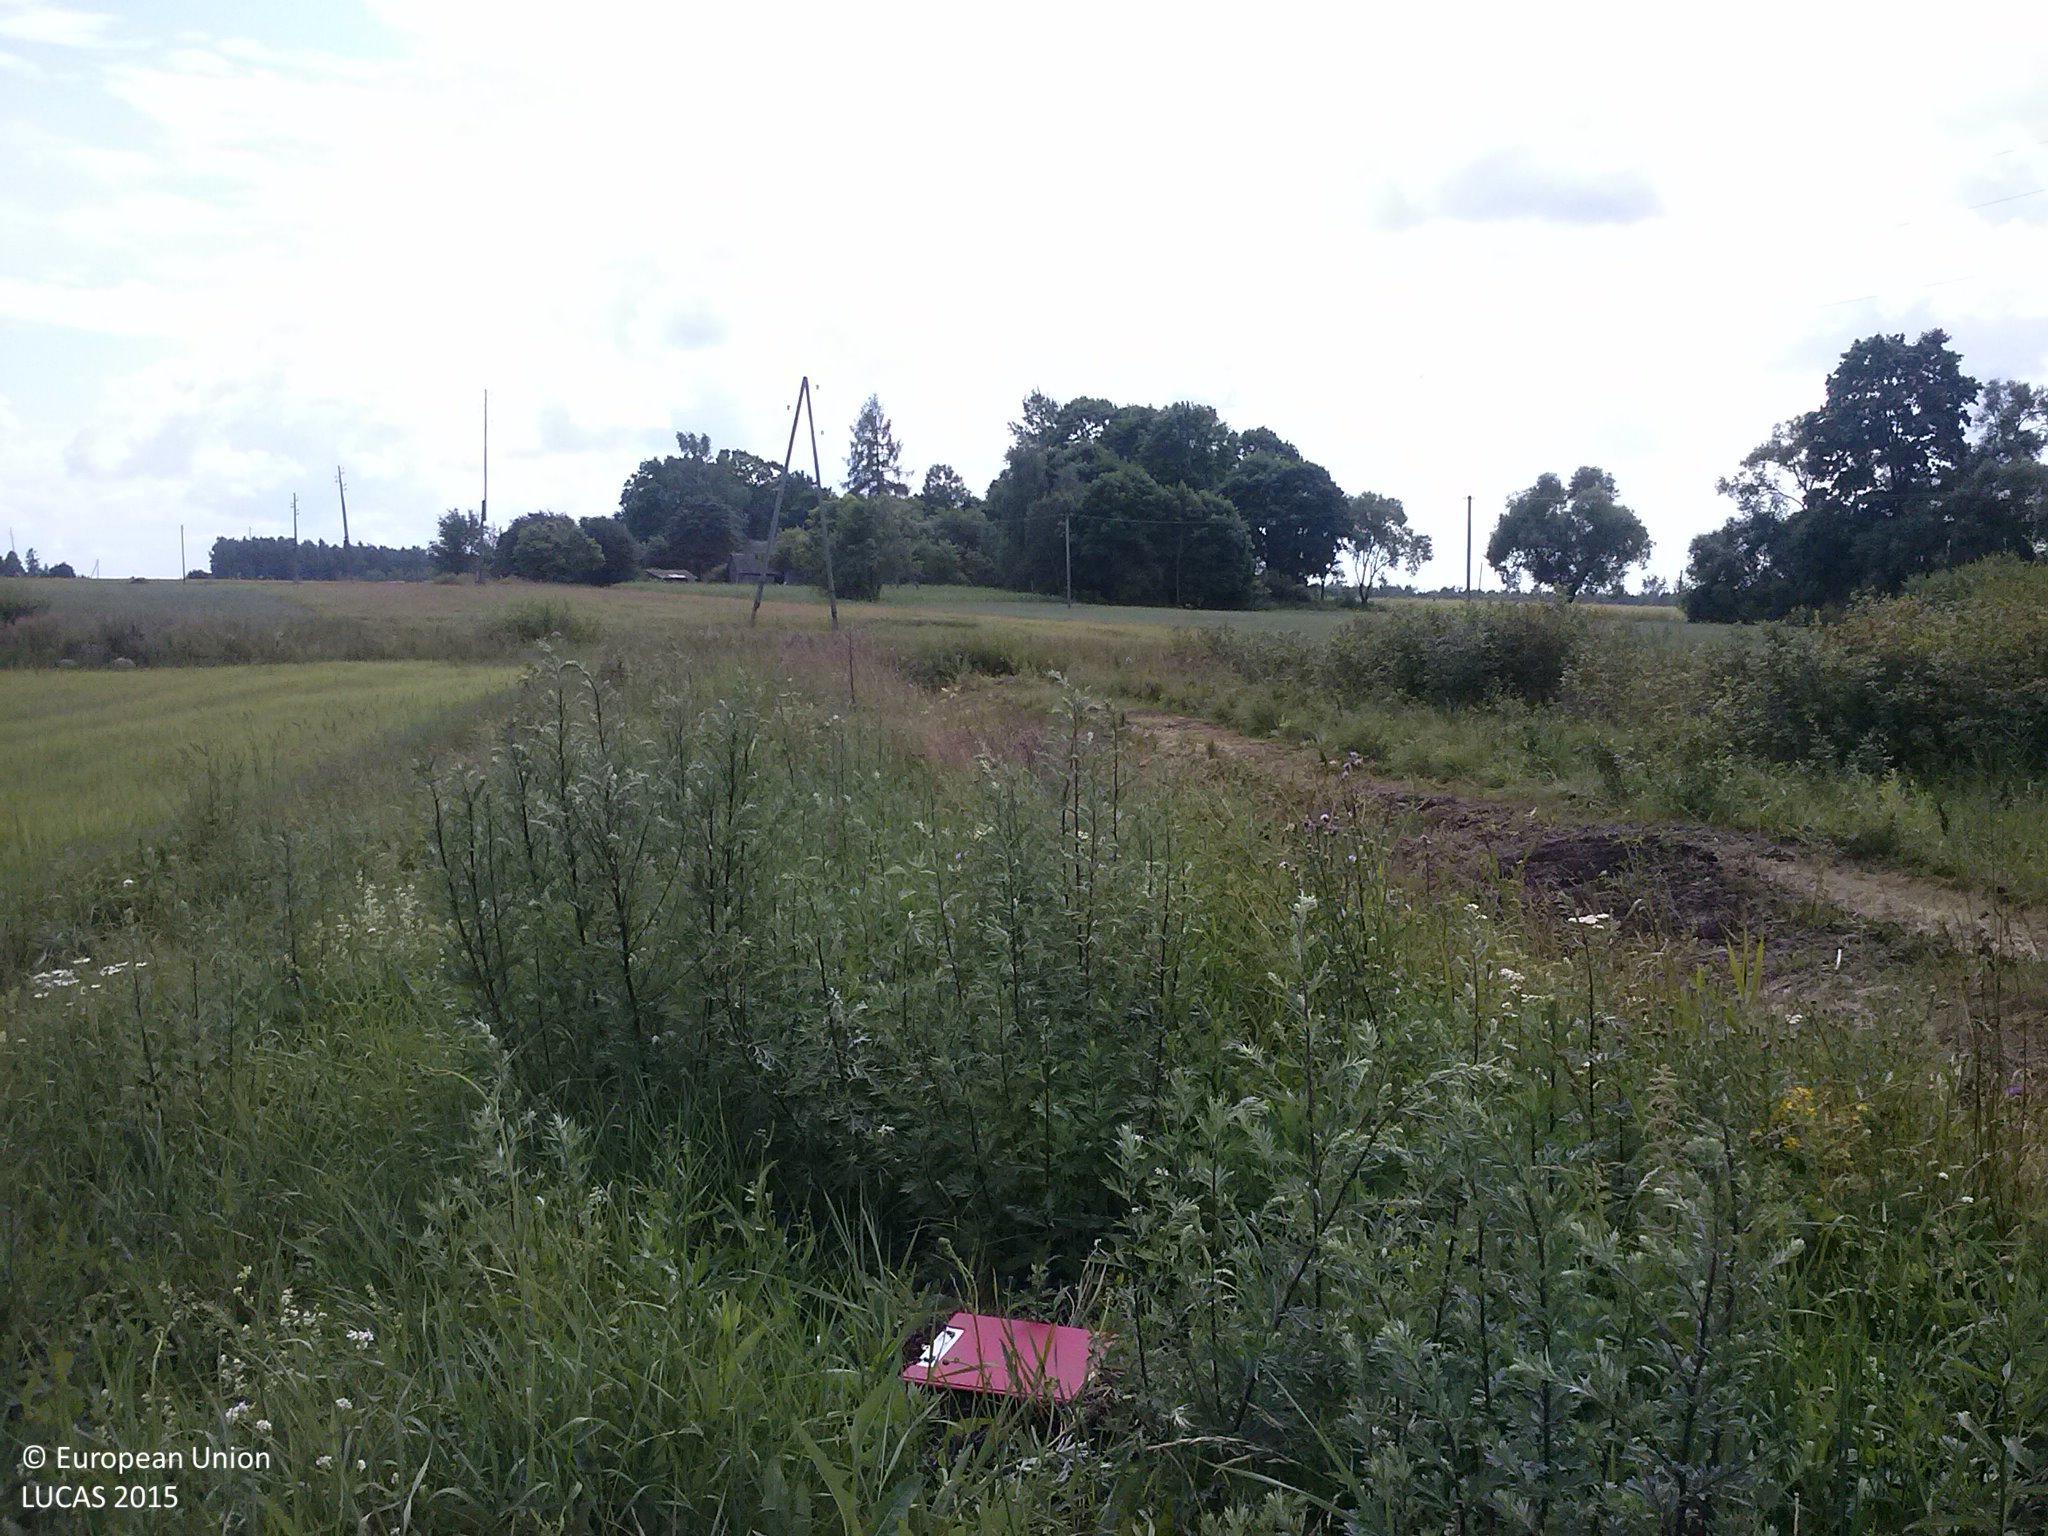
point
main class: Grassland
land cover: Spontaneously vegetated surfaces
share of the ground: > 75 %
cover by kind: herbaceous plants 100 %
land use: Fallow land
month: July
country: LV
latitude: 56.7826
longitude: 27.6129
